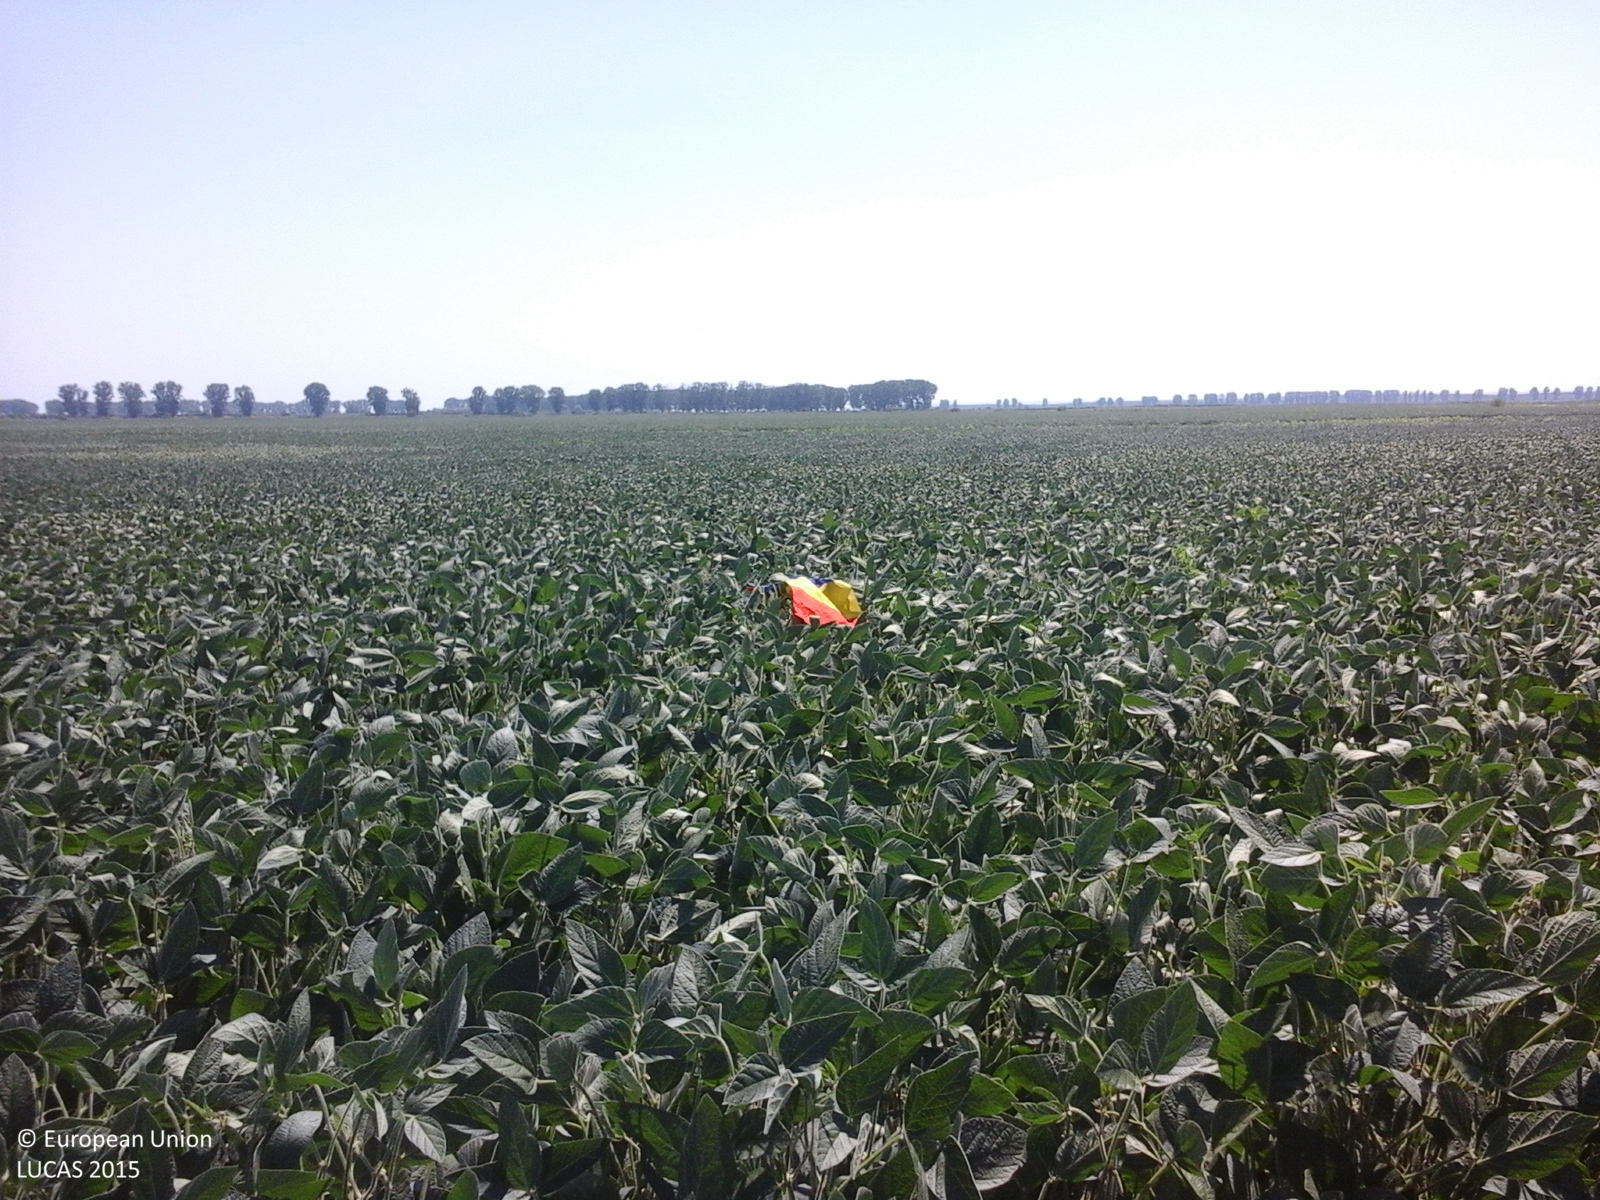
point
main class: Cropland
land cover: Soya
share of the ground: > 75 %
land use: Agriculture (excluding fallow land and kitchen gardens)
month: July
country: RO
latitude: 44.1822
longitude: 27.0260
